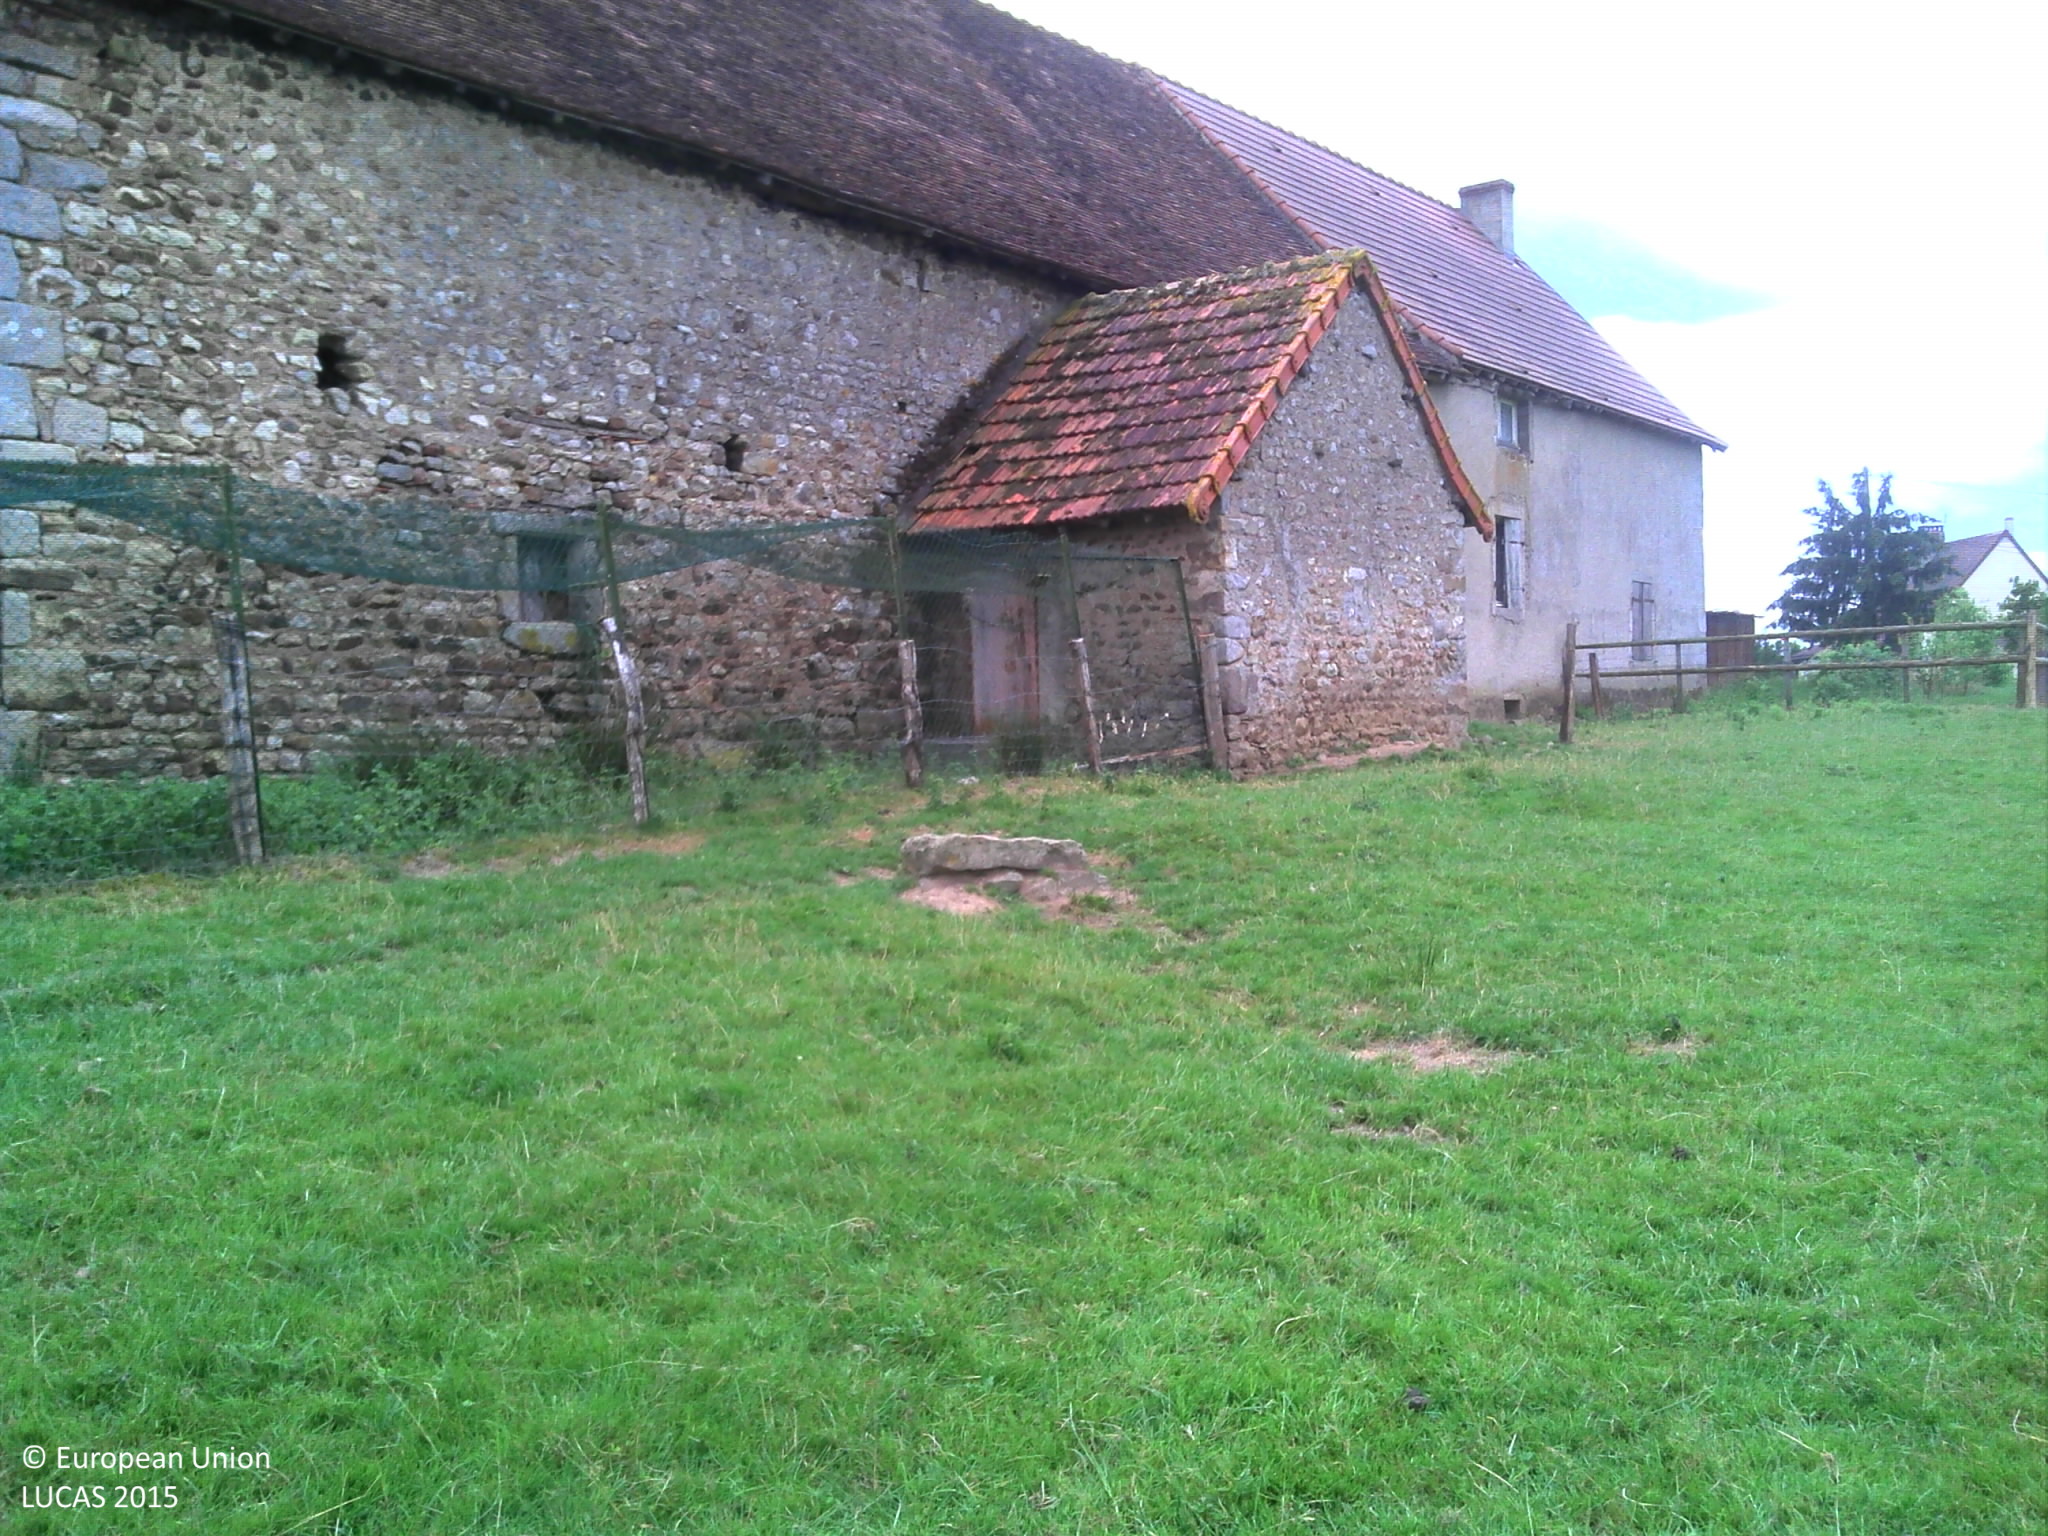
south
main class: Grassland
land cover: Grassland without tree/shrub cover
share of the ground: > 75 %
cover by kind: herbaceous plants 100 %
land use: Agriculture (excluding fallow land and kitchen gardens)
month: June
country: FR
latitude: 46.5505
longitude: 4.4581
